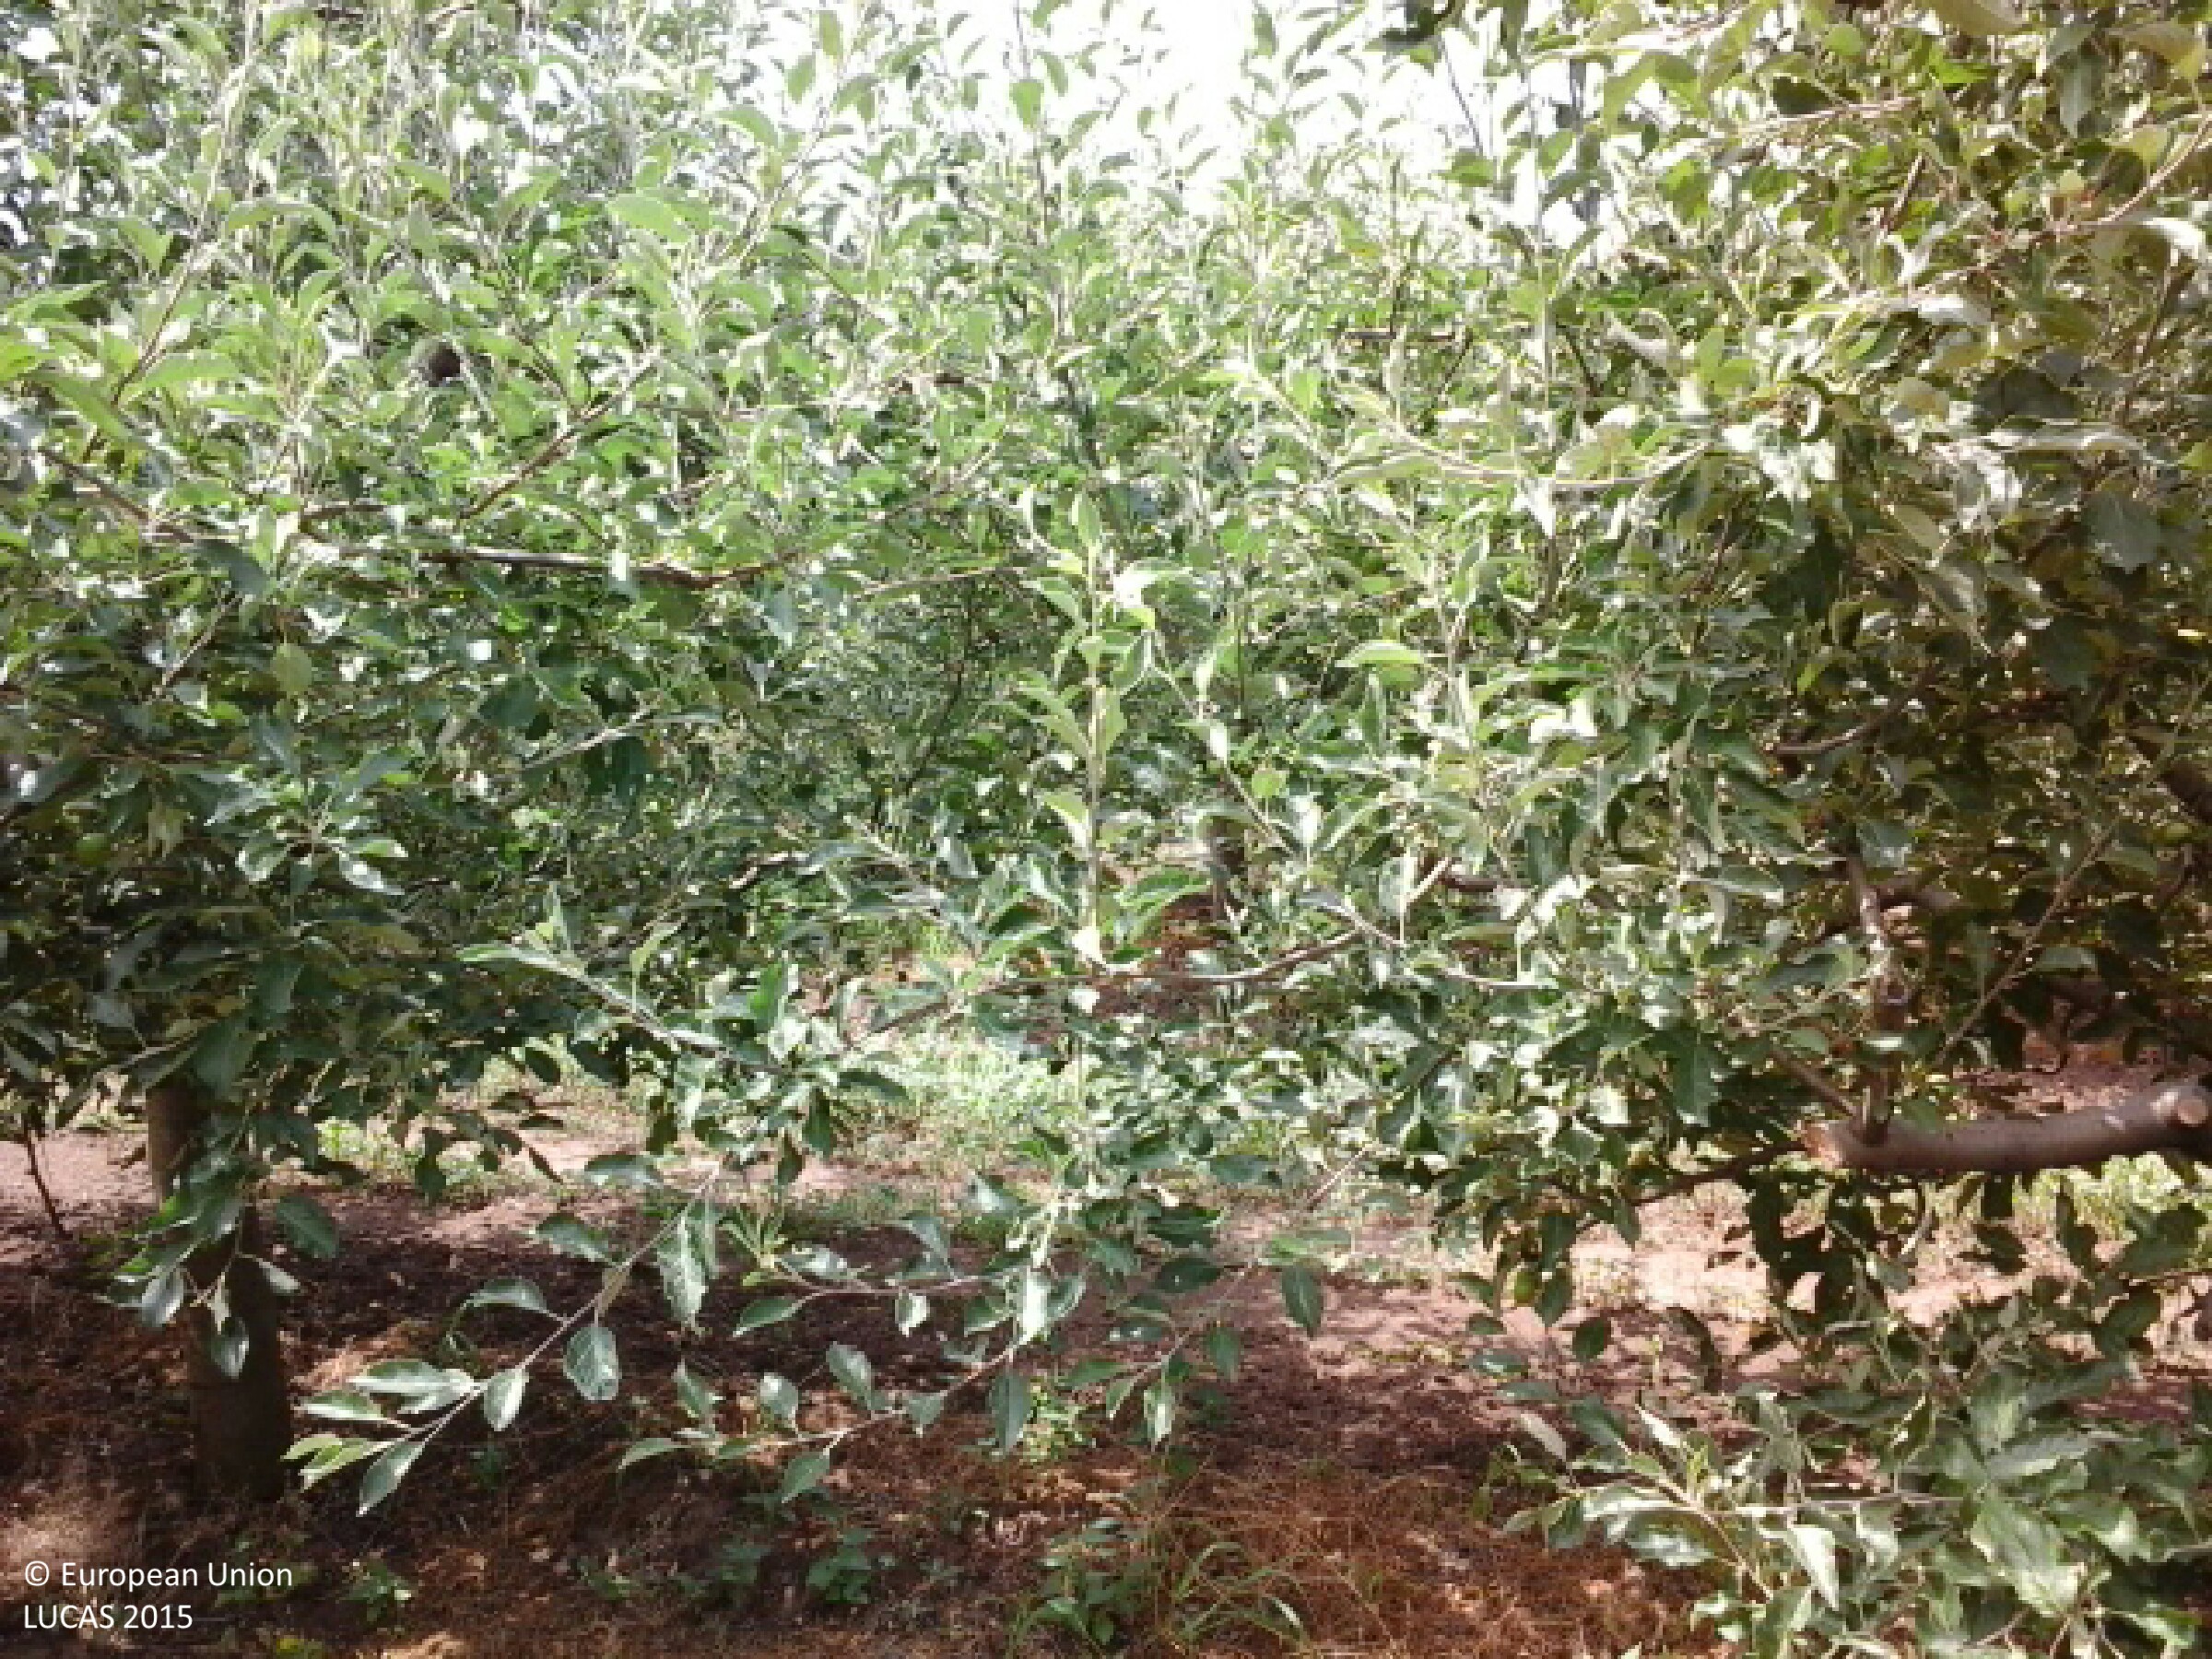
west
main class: Cropland
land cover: Apple fruit
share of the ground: 50 - 75 %
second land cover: Grassland without tree/shrub cover
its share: > 75 %
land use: Agriculture (excluding fallow land and kitchen gardens)
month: June
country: HU
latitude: 47.8390
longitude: 21.6574
